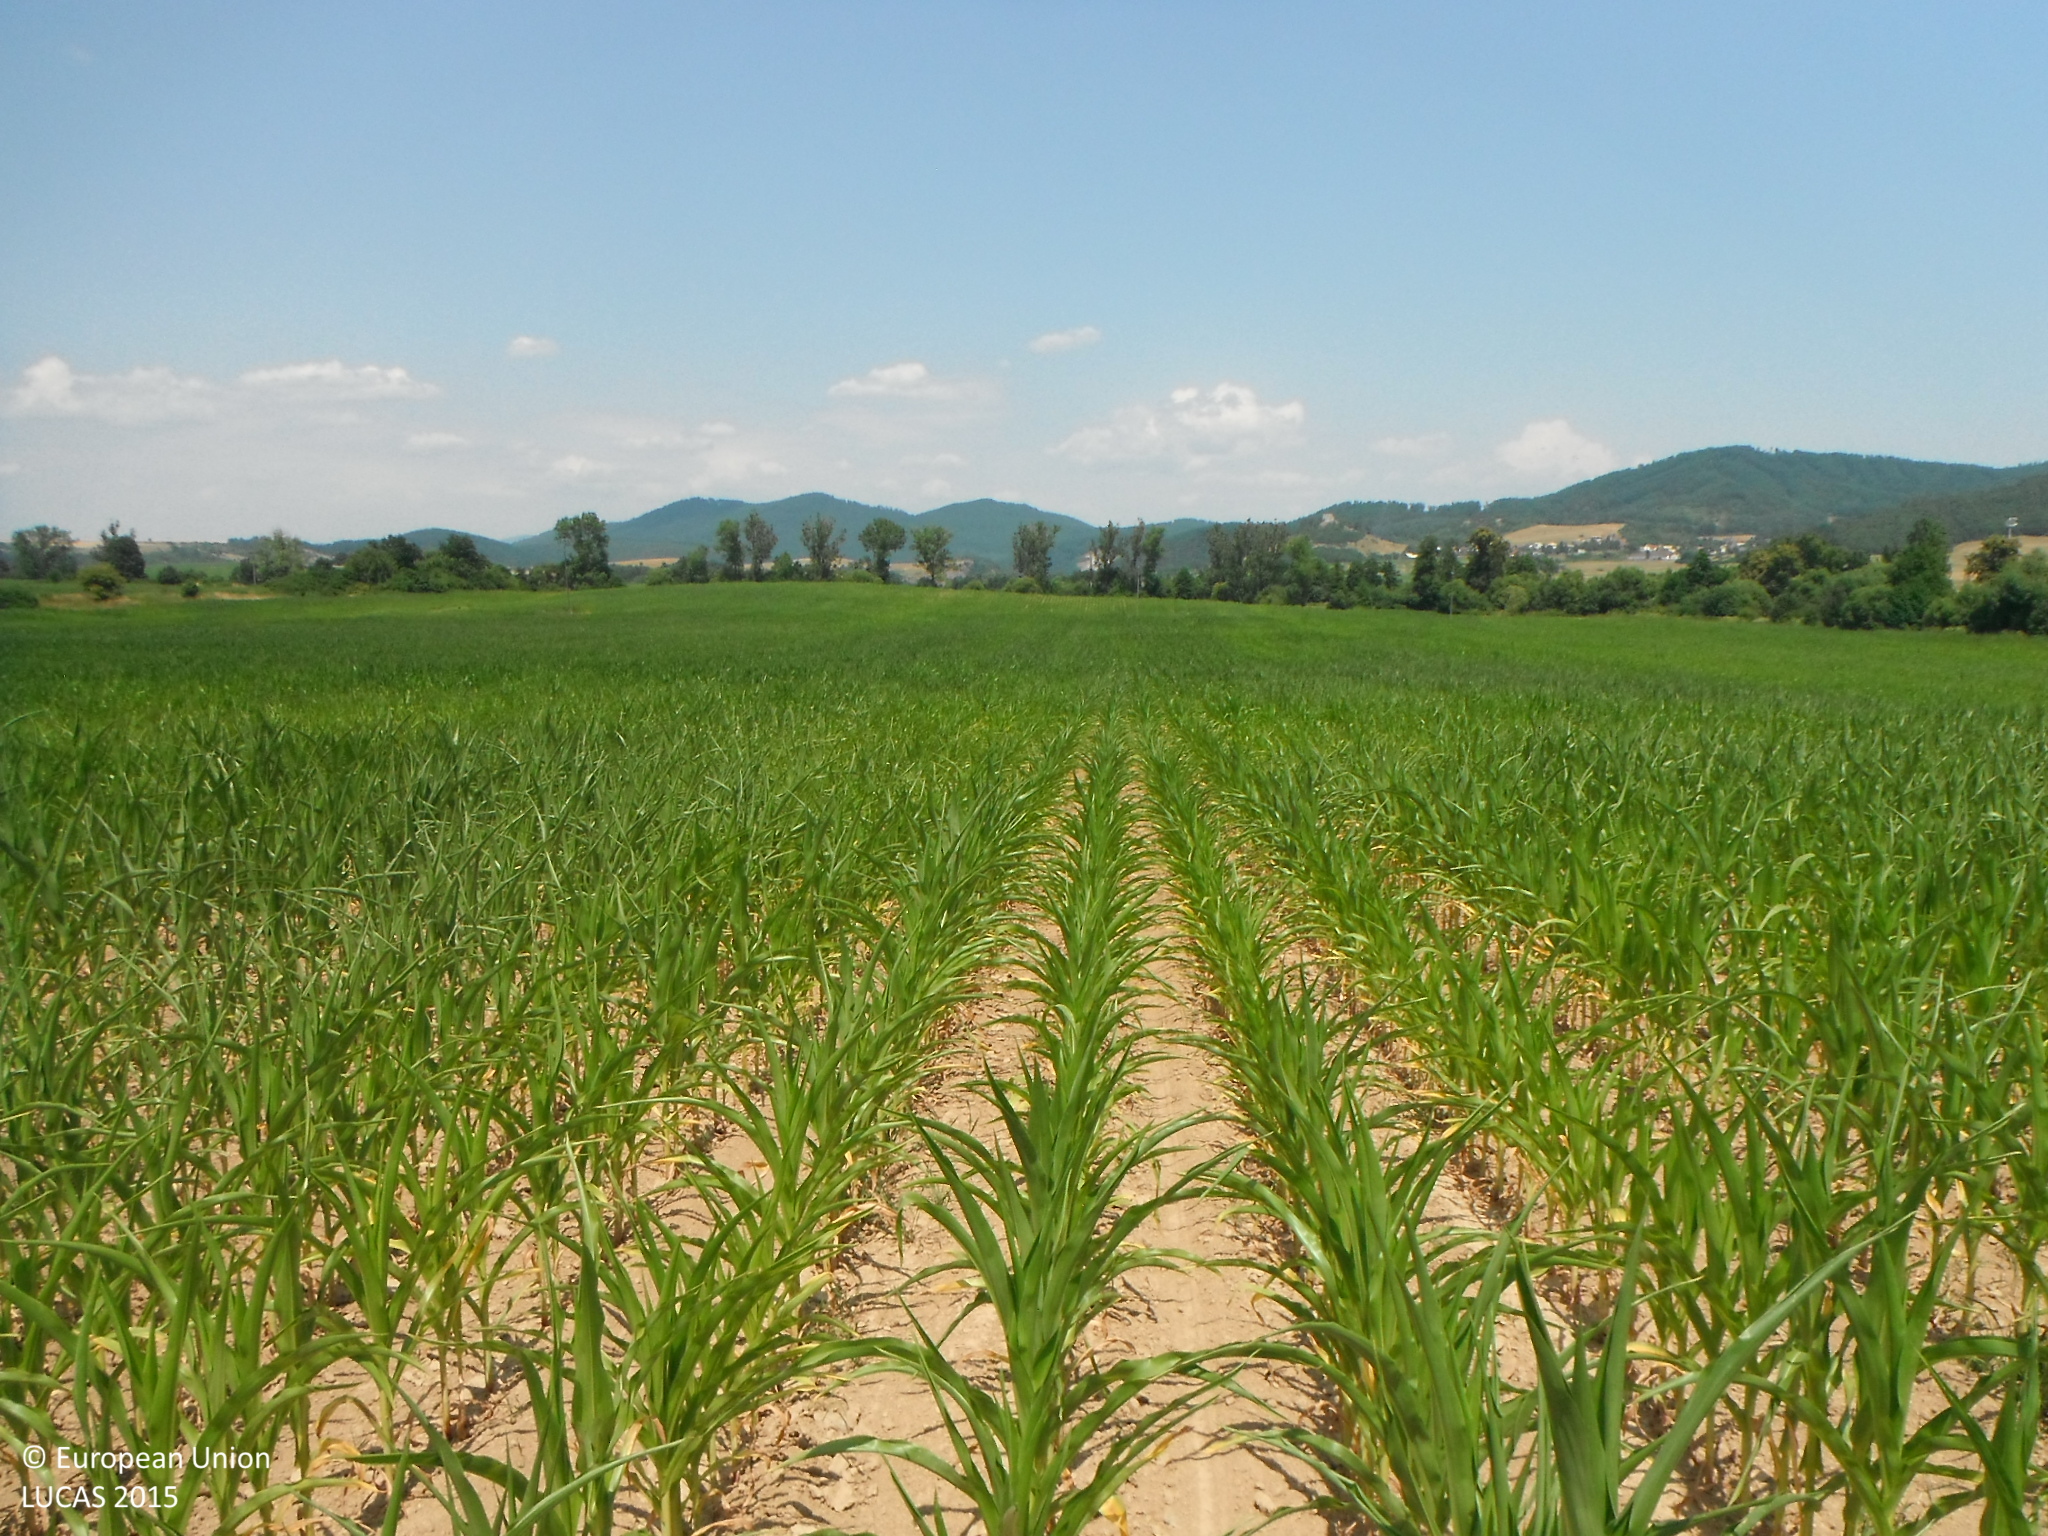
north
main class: Cropland
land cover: Maize
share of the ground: 50 - 75 %
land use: Agriculture (excluding fallow land and kitchen gardens)
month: July
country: SK
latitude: 48.4803
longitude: 19.0989
